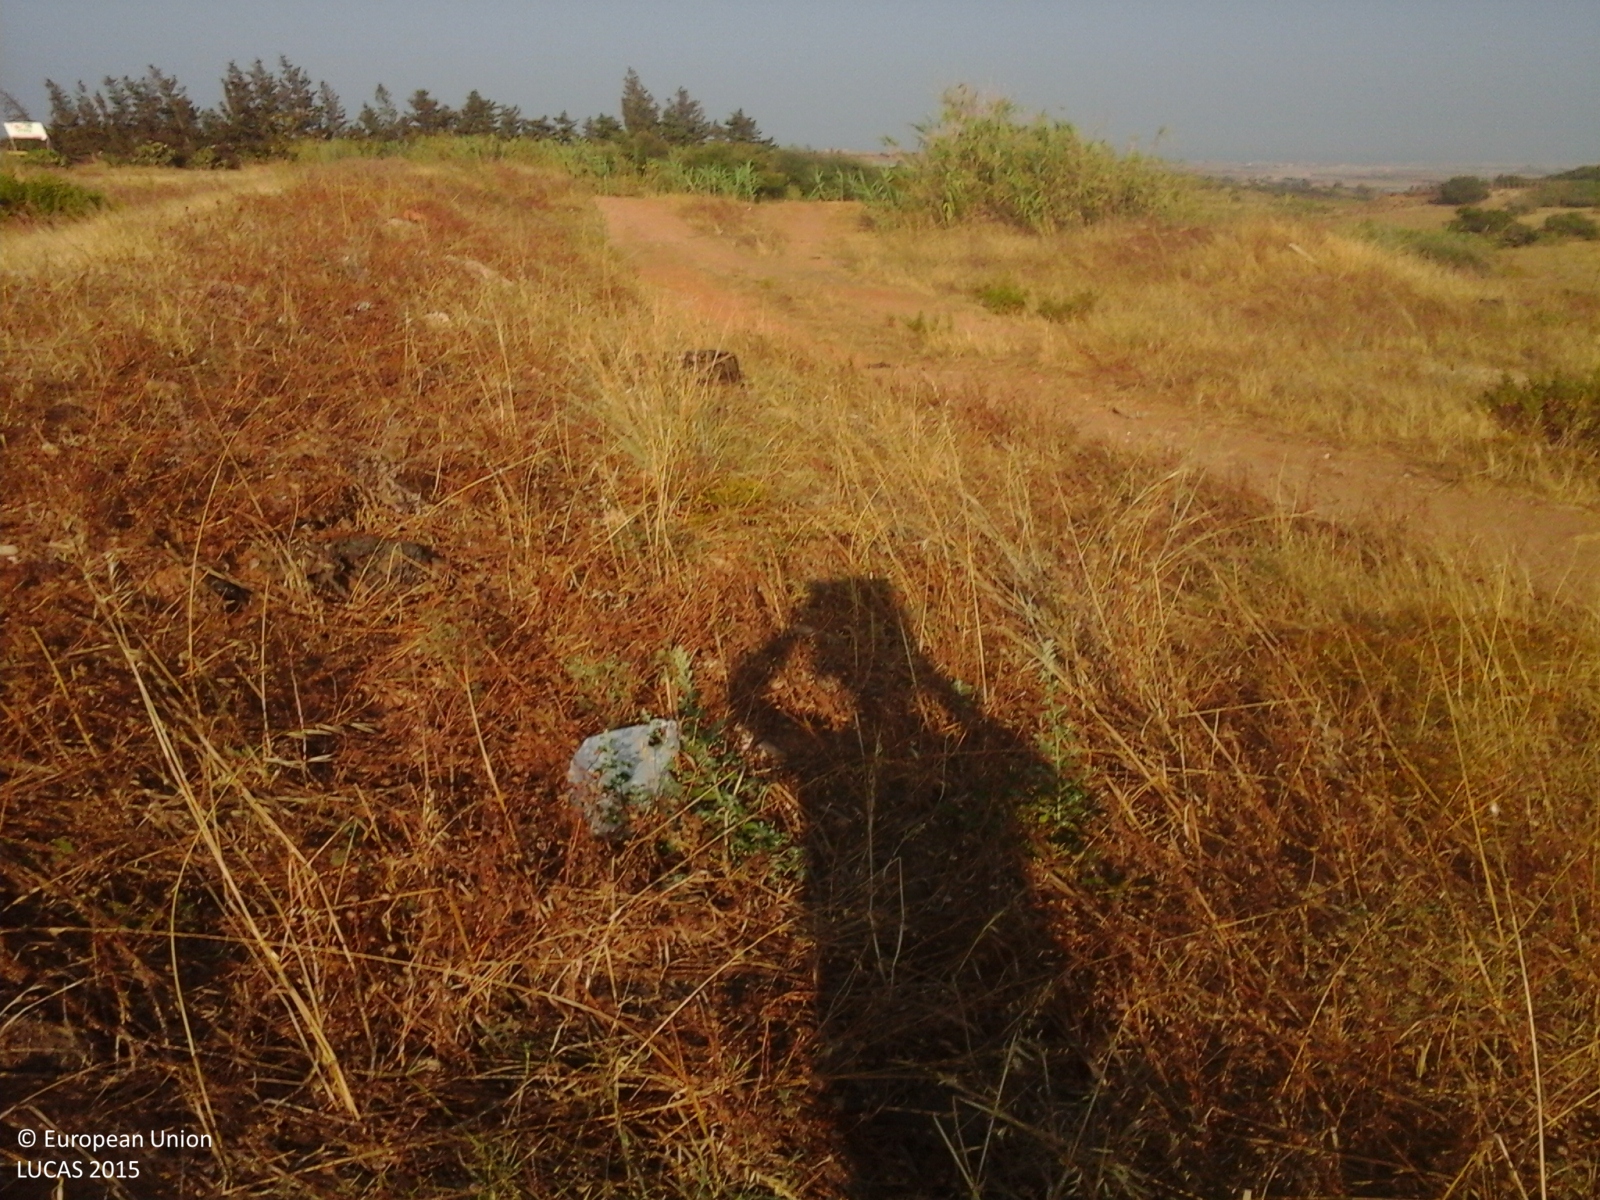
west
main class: Grassland
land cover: Grassland without tree/shrub cover
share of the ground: > 75 %
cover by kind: herbaceous plants 100 %
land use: Abandoned areas
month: July
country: IT
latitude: 36.9909
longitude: 14.4031
